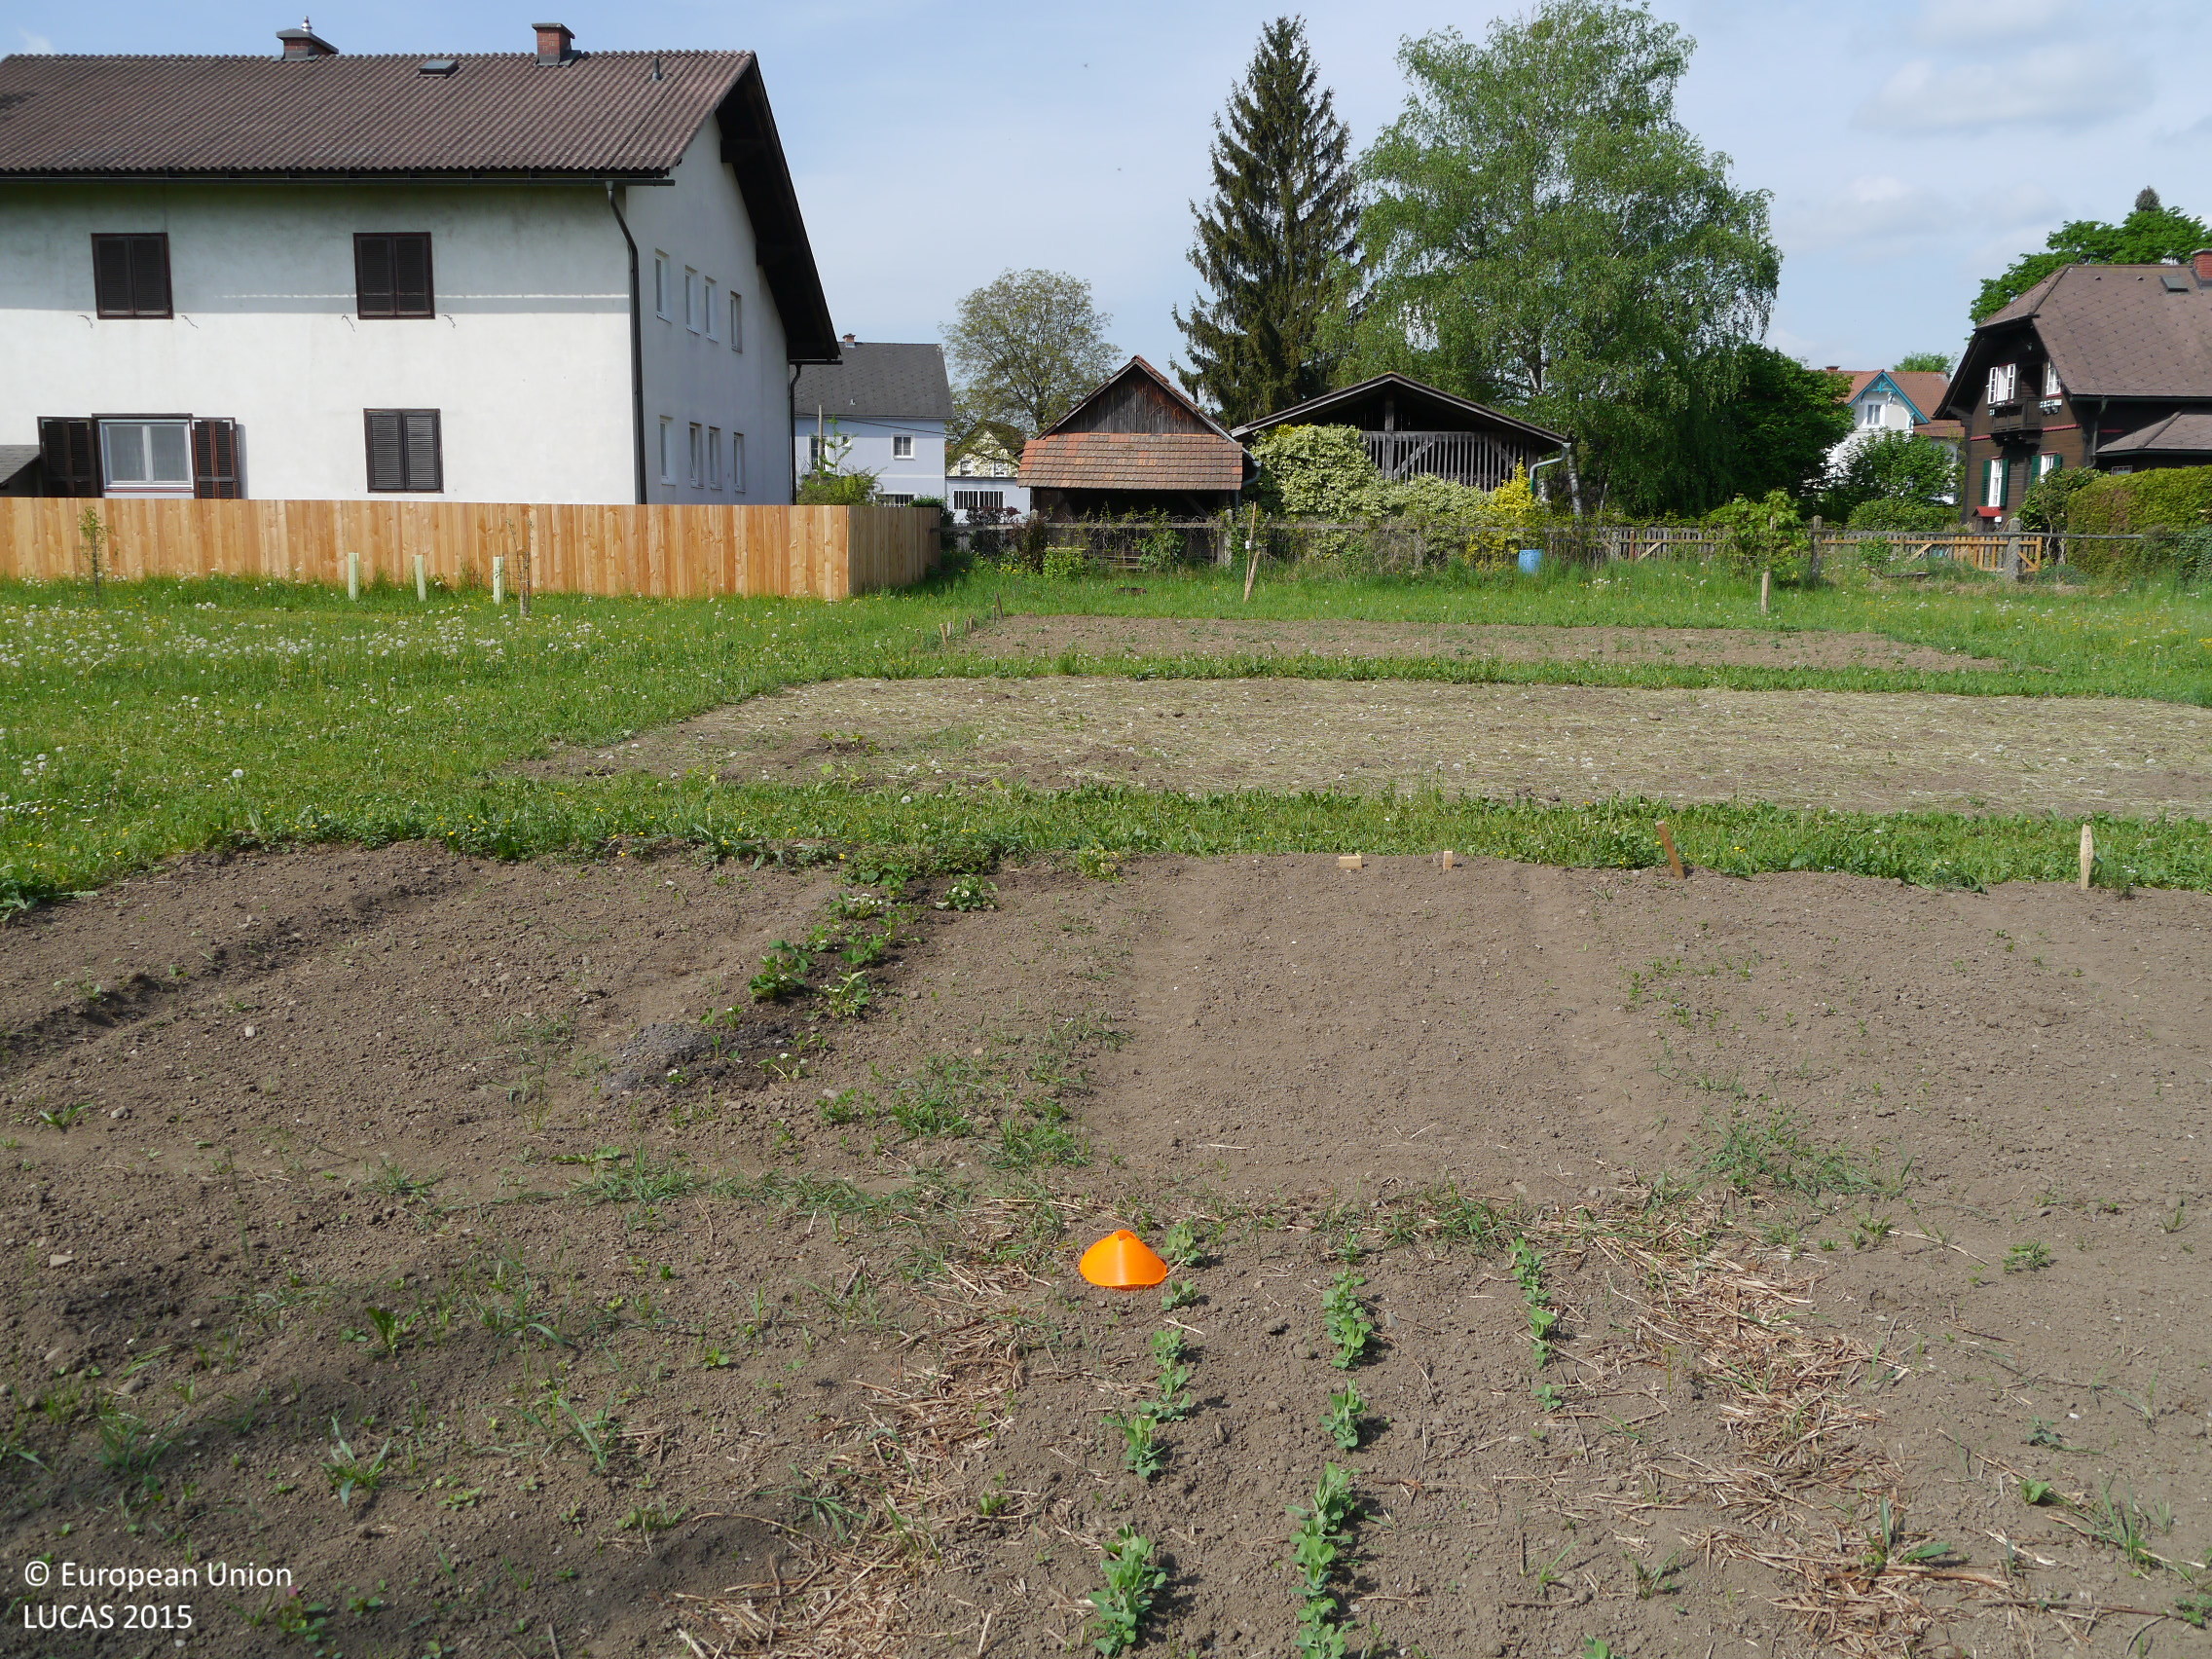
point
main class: Cropland
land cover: Other fresh vegetables
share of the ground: 50 - 75 %
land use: Kitchen garden
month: May
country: AT
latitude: 47.1202
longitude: 15.3379
